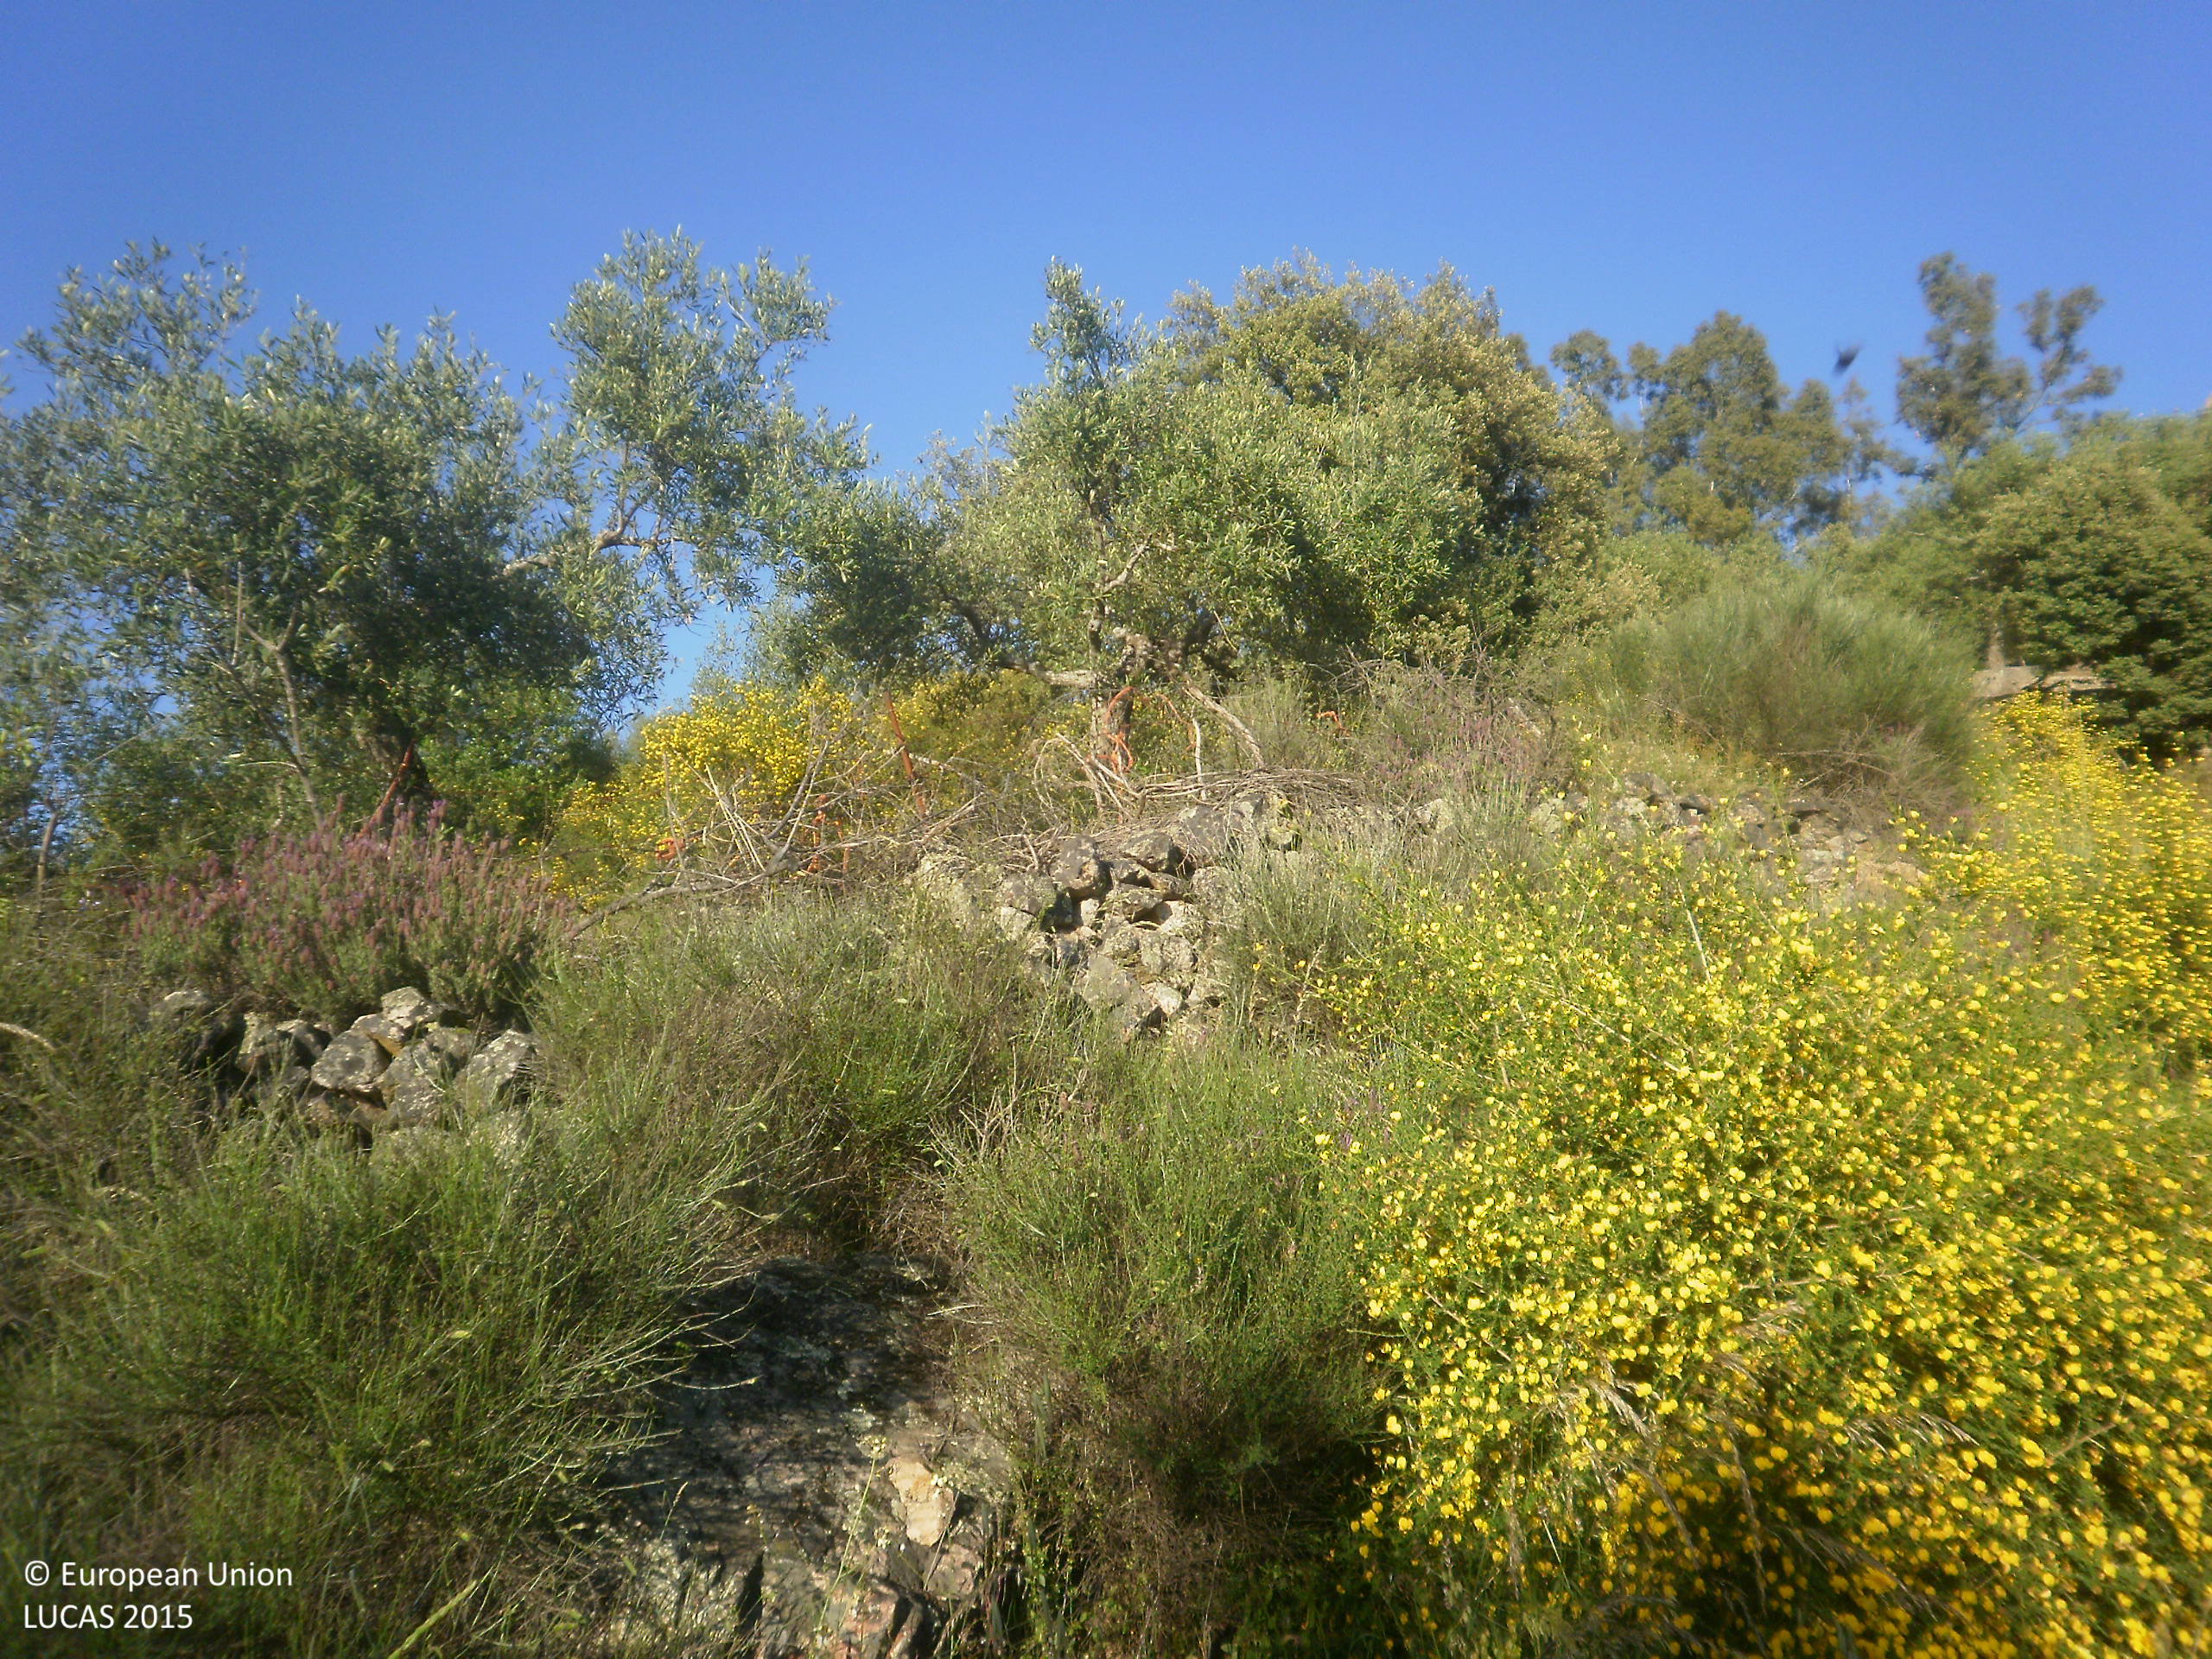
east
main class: Grassland
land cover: Grassland with sparse tree/shrub cover
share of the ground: > 75 %
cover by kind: herbaceous plants 90 %, broadleaved forest trees 5 %, shrubs 5 %
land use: Agriculture (excluding fallow land and kitchen gardens)
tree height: > 5 m
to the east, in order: Grassland with sparse tree/shrub cover
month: April
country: ES
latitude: 38.9591
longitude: -5.2370
